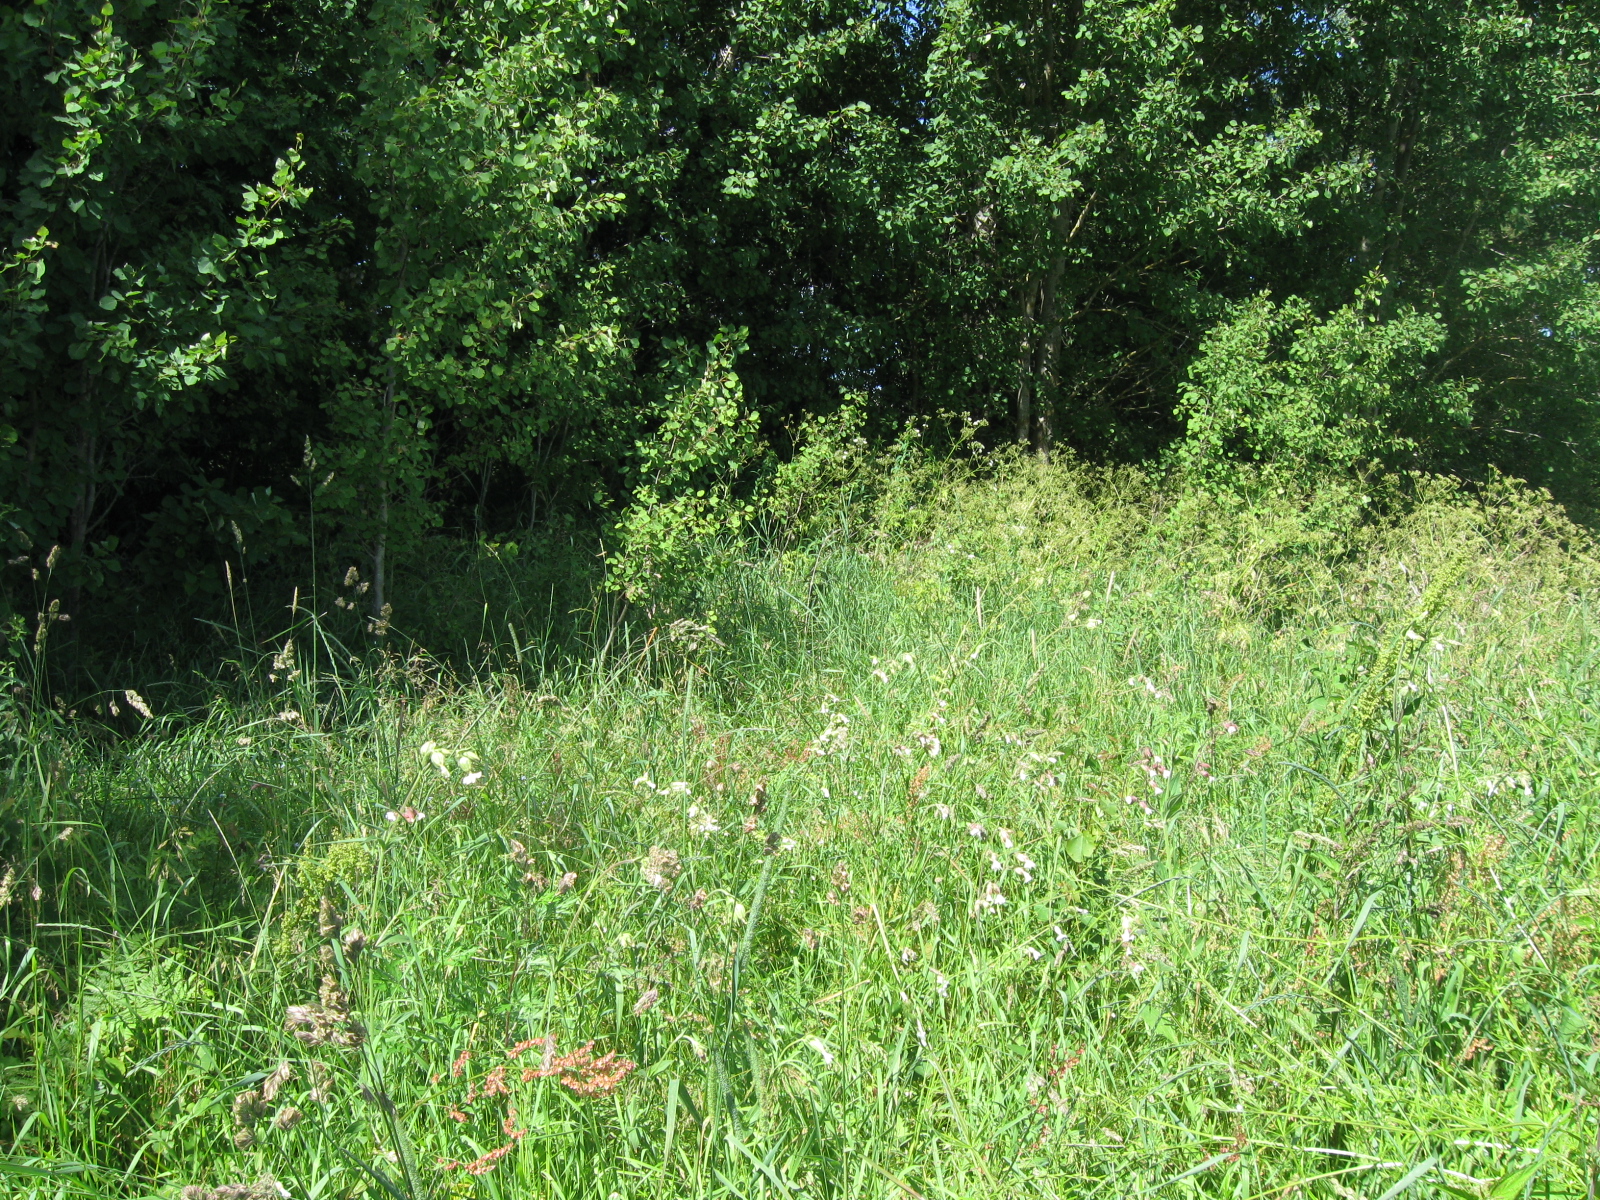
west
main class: Grassland
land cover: Spontaneously vegetated surfaces
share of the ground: > 75 %
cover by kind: herbaceous plants 100 %
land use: Abandoned areas
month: June
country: LT
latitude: 53.9798
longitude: 24.7013
